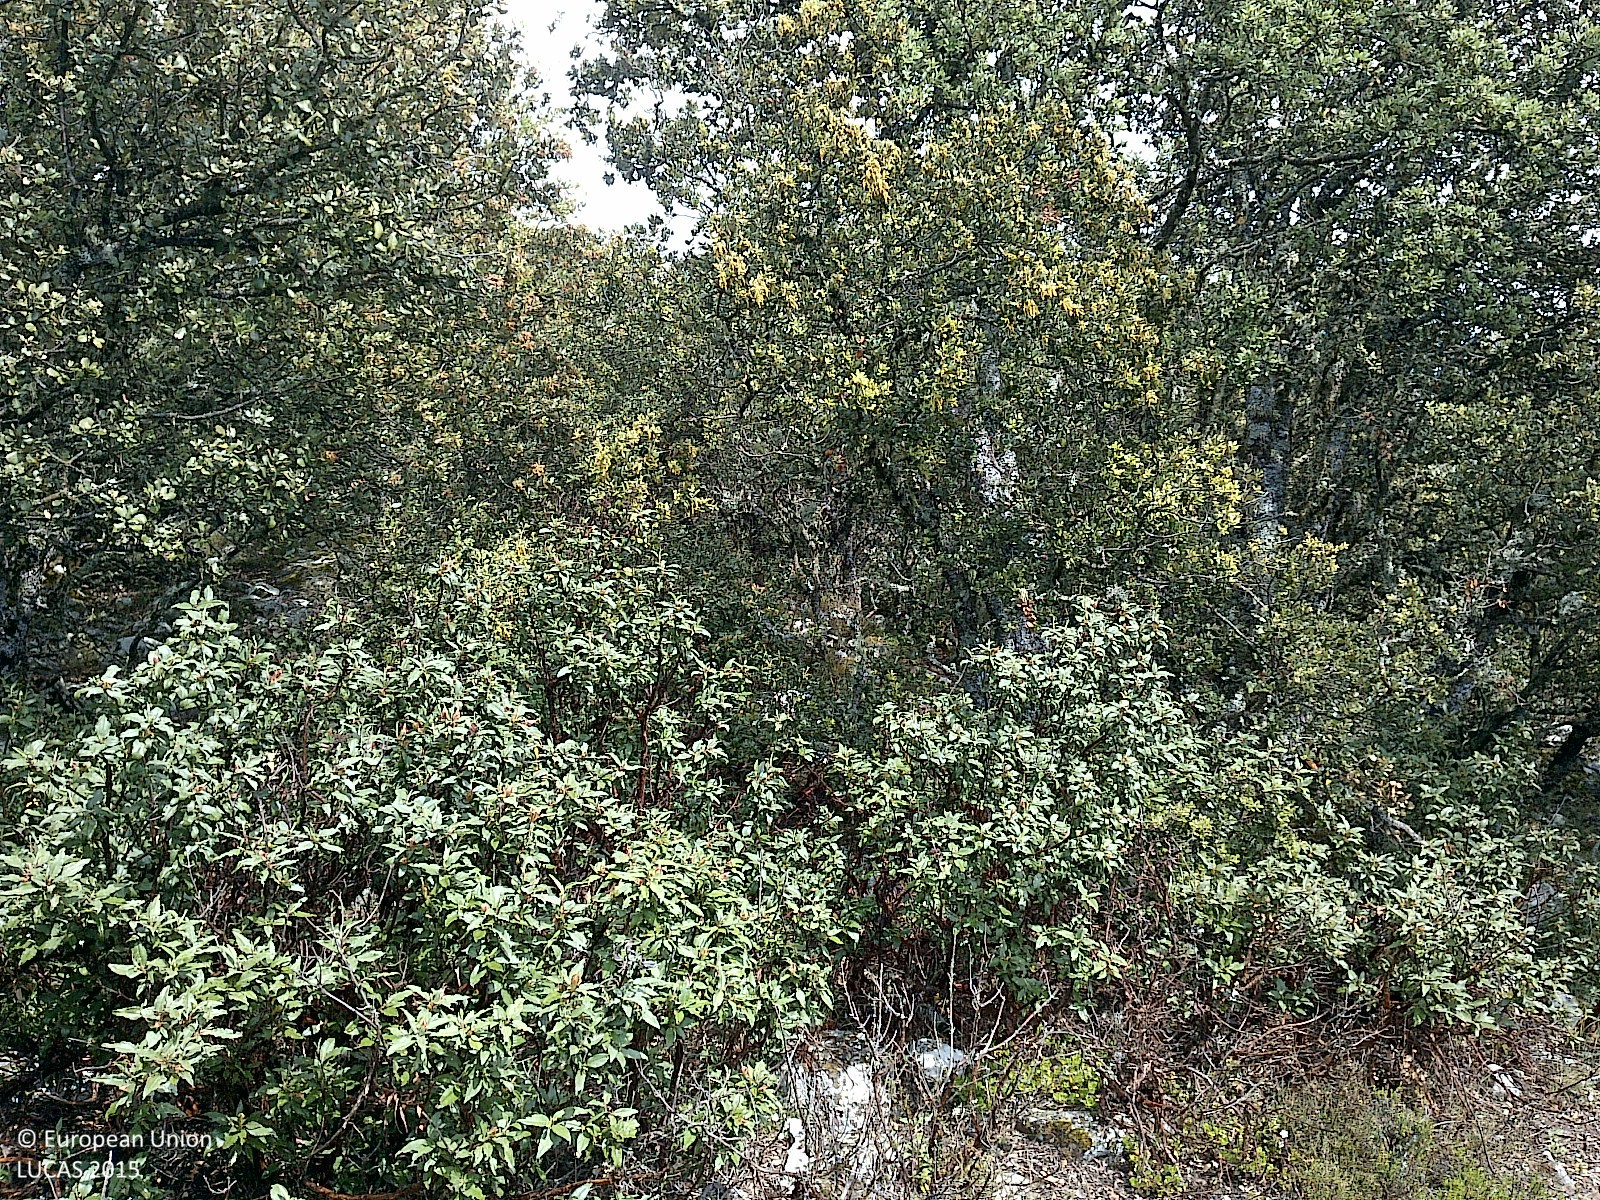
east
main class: Woodland
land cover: Broadleaved woodland
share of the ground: > 75 %
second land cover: Shrubland without tree cover
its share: 50 - 75 %
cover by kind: broadleaved forest trees 75 %, shrubs 15 %, herbaceous plants 5 %, consolidated bare surface 5 %
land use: Forestry
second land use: Agriculture (excluding fallow land and kitchen gardens)
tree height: < 5 m
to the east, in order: Broadleaved woodland; Shrubland without tree cover; Rock outcrops; Broadleaved woodland
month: May
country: ES
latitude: 41.8156
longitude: -2.2548
